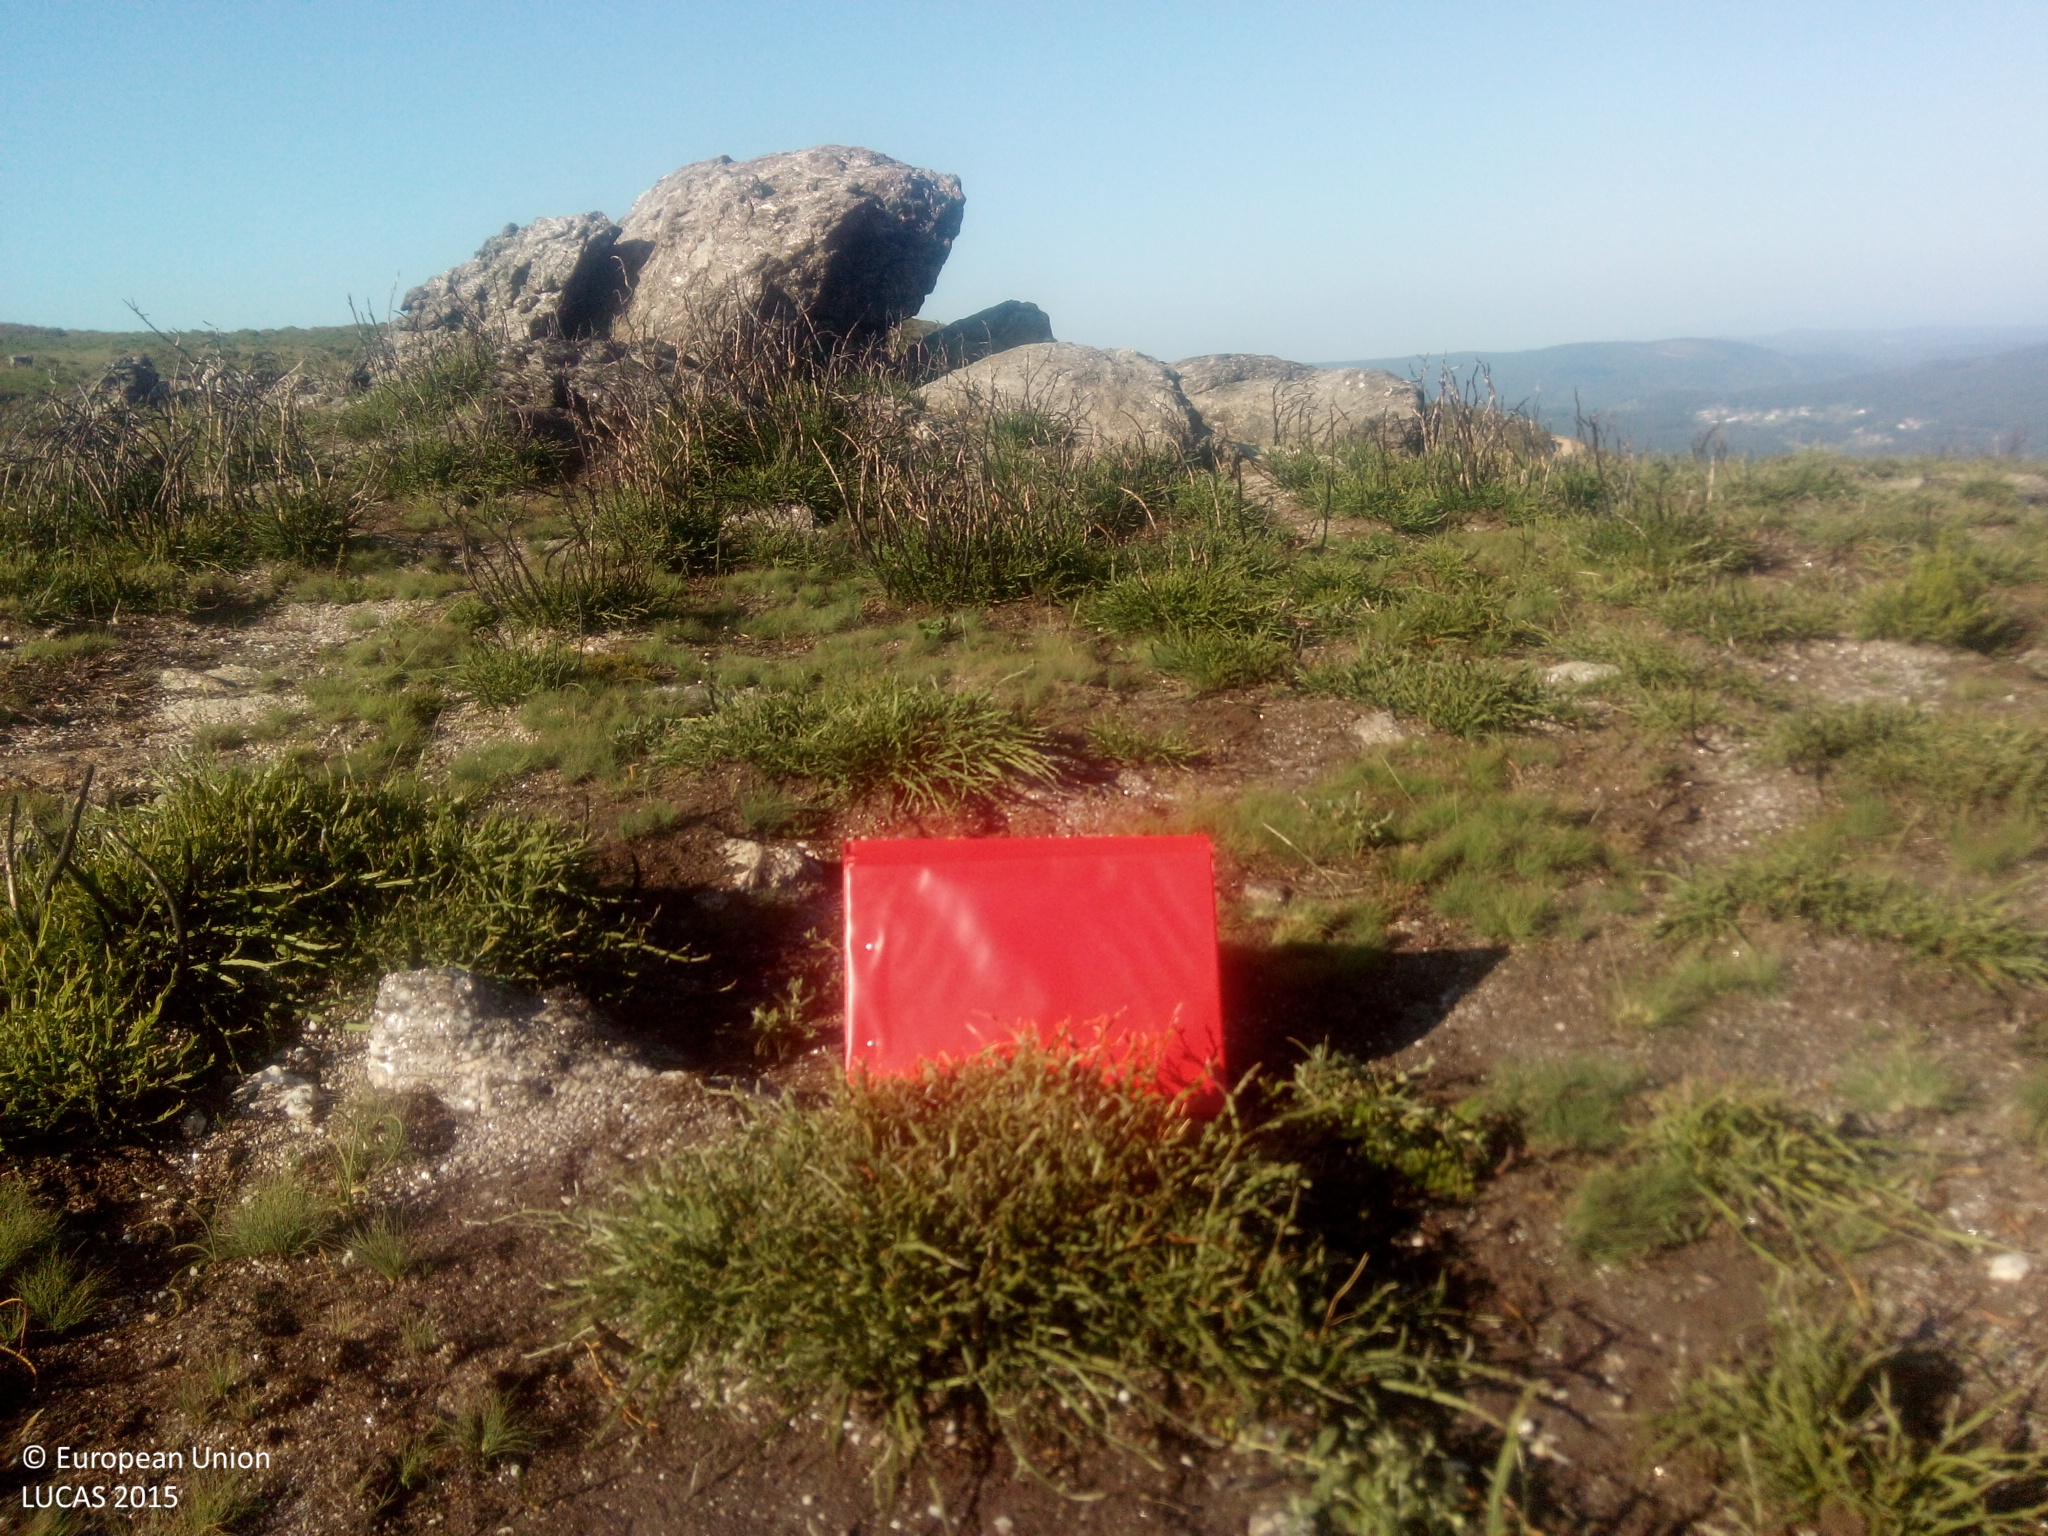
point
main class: Shrubland
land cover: Shrubland without tree cover
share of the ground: > 75 %
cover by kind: shrubs 100 %
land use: Semi-natural and natural areas not in use
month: June
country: ES
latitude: 42.2043
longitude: -8.2165
